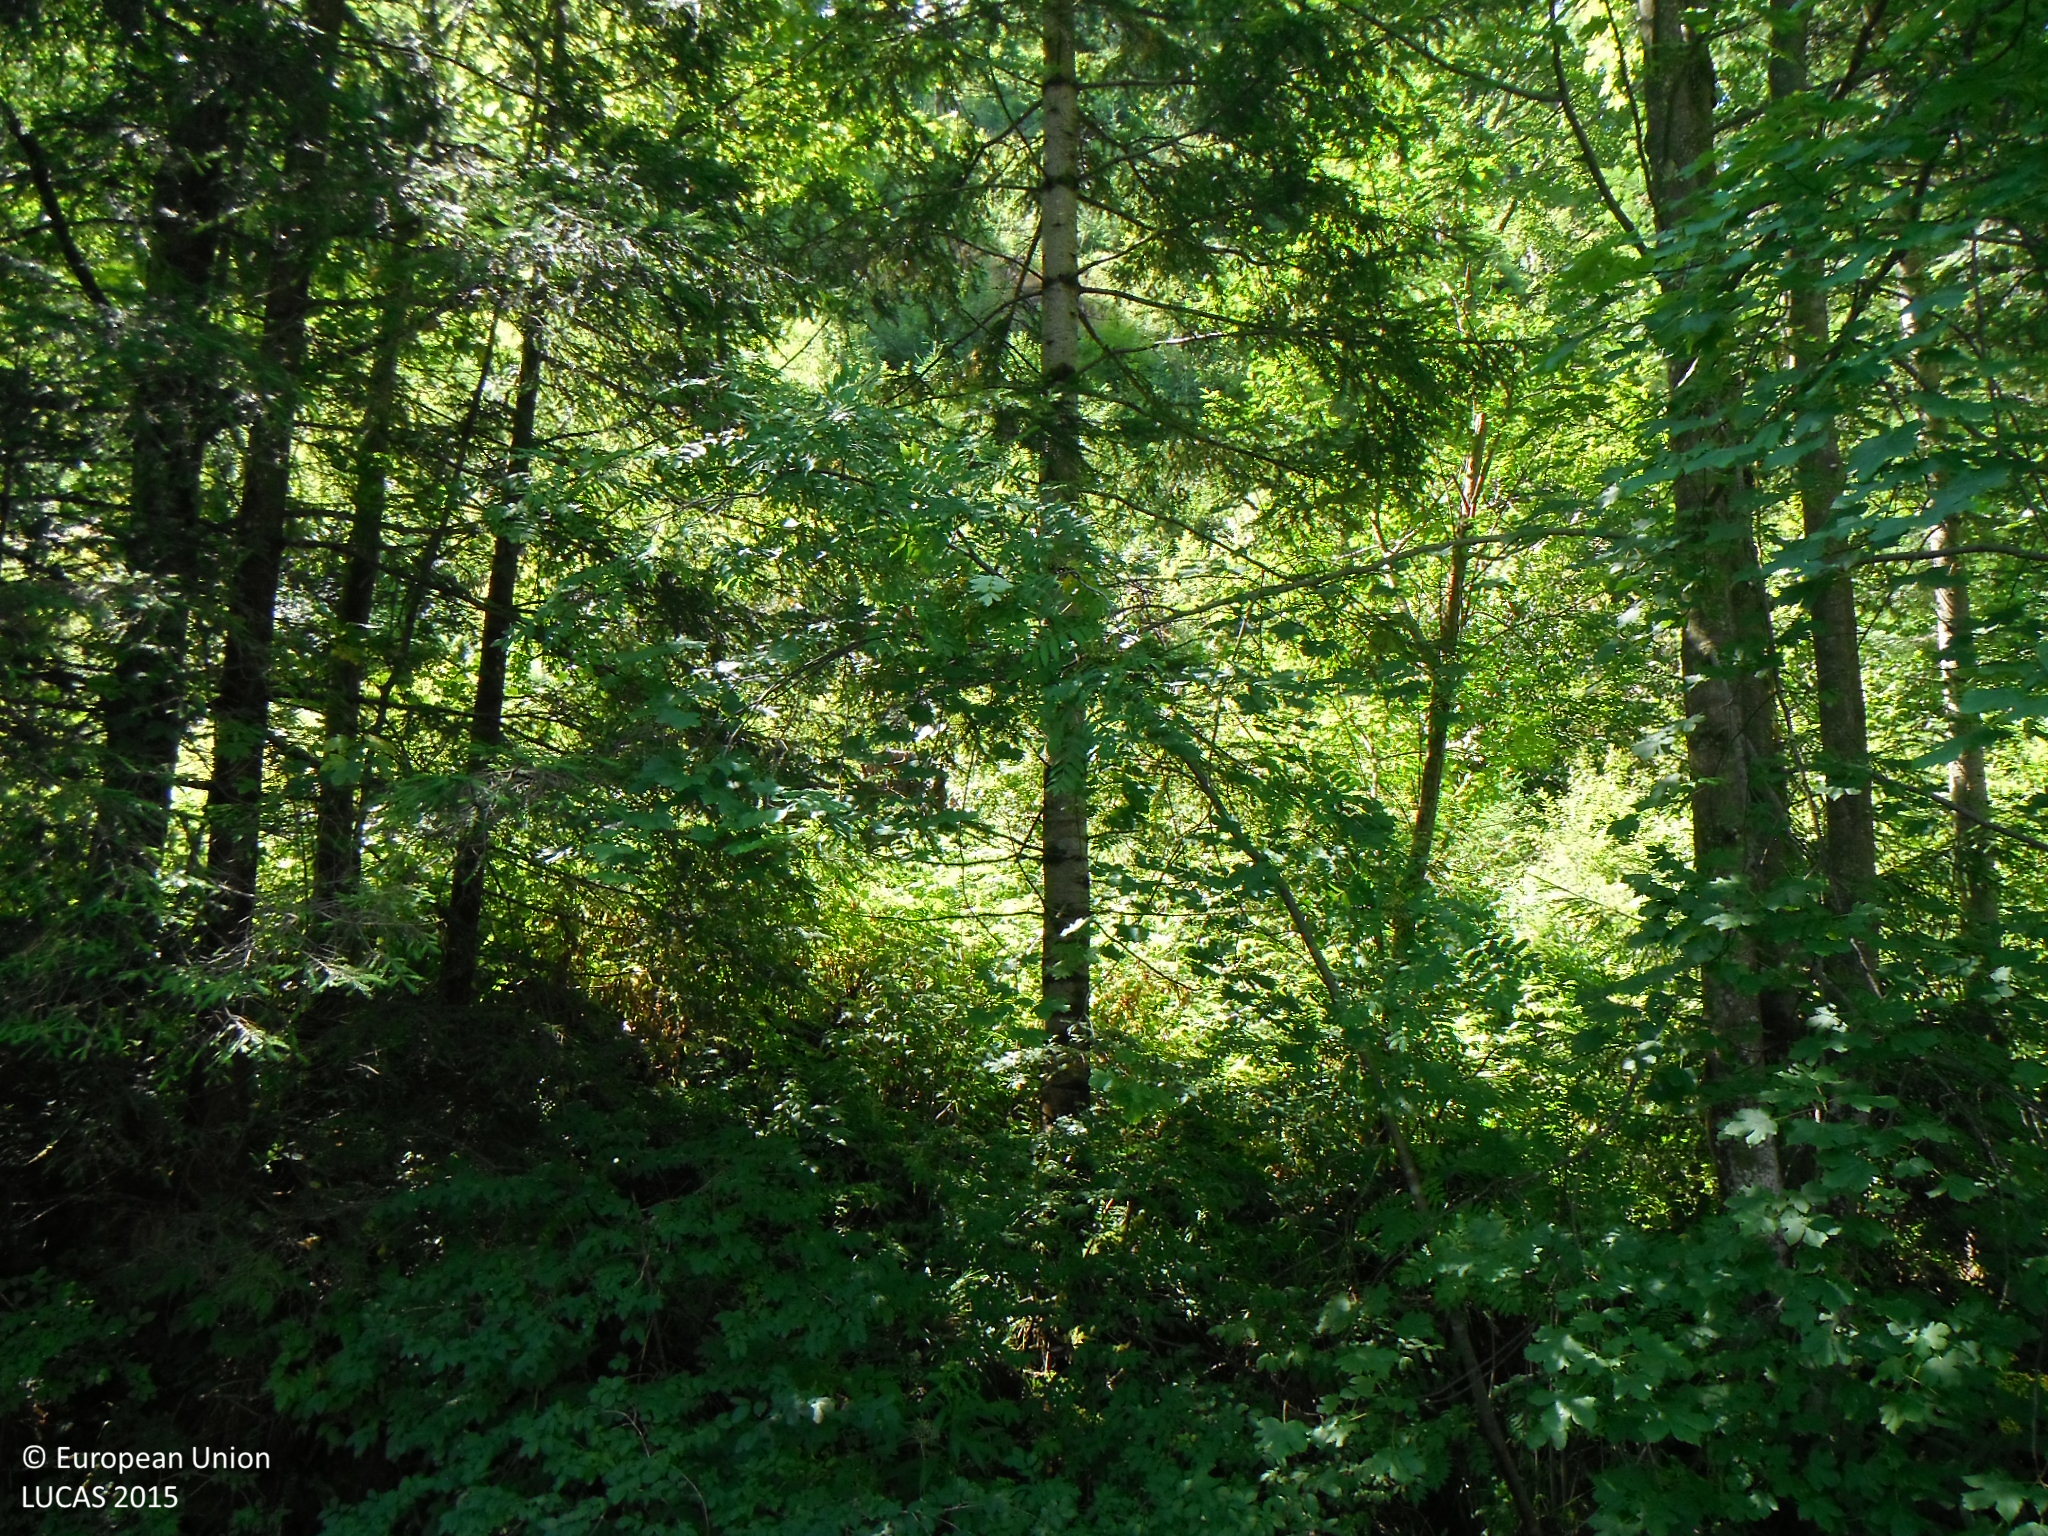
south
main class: Woodland
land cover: Spruce dominated mixed woodland
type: mountainous beech forest
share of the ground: > 75 %
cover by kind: broadleaved forest trees 50 %, coniferous forest trees 25 %, shrubs 15 %, herbaceous plants 10 %
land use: Forestry
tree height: > 5 m
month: July
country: SK
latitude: 48.8848
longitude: 19.6689
